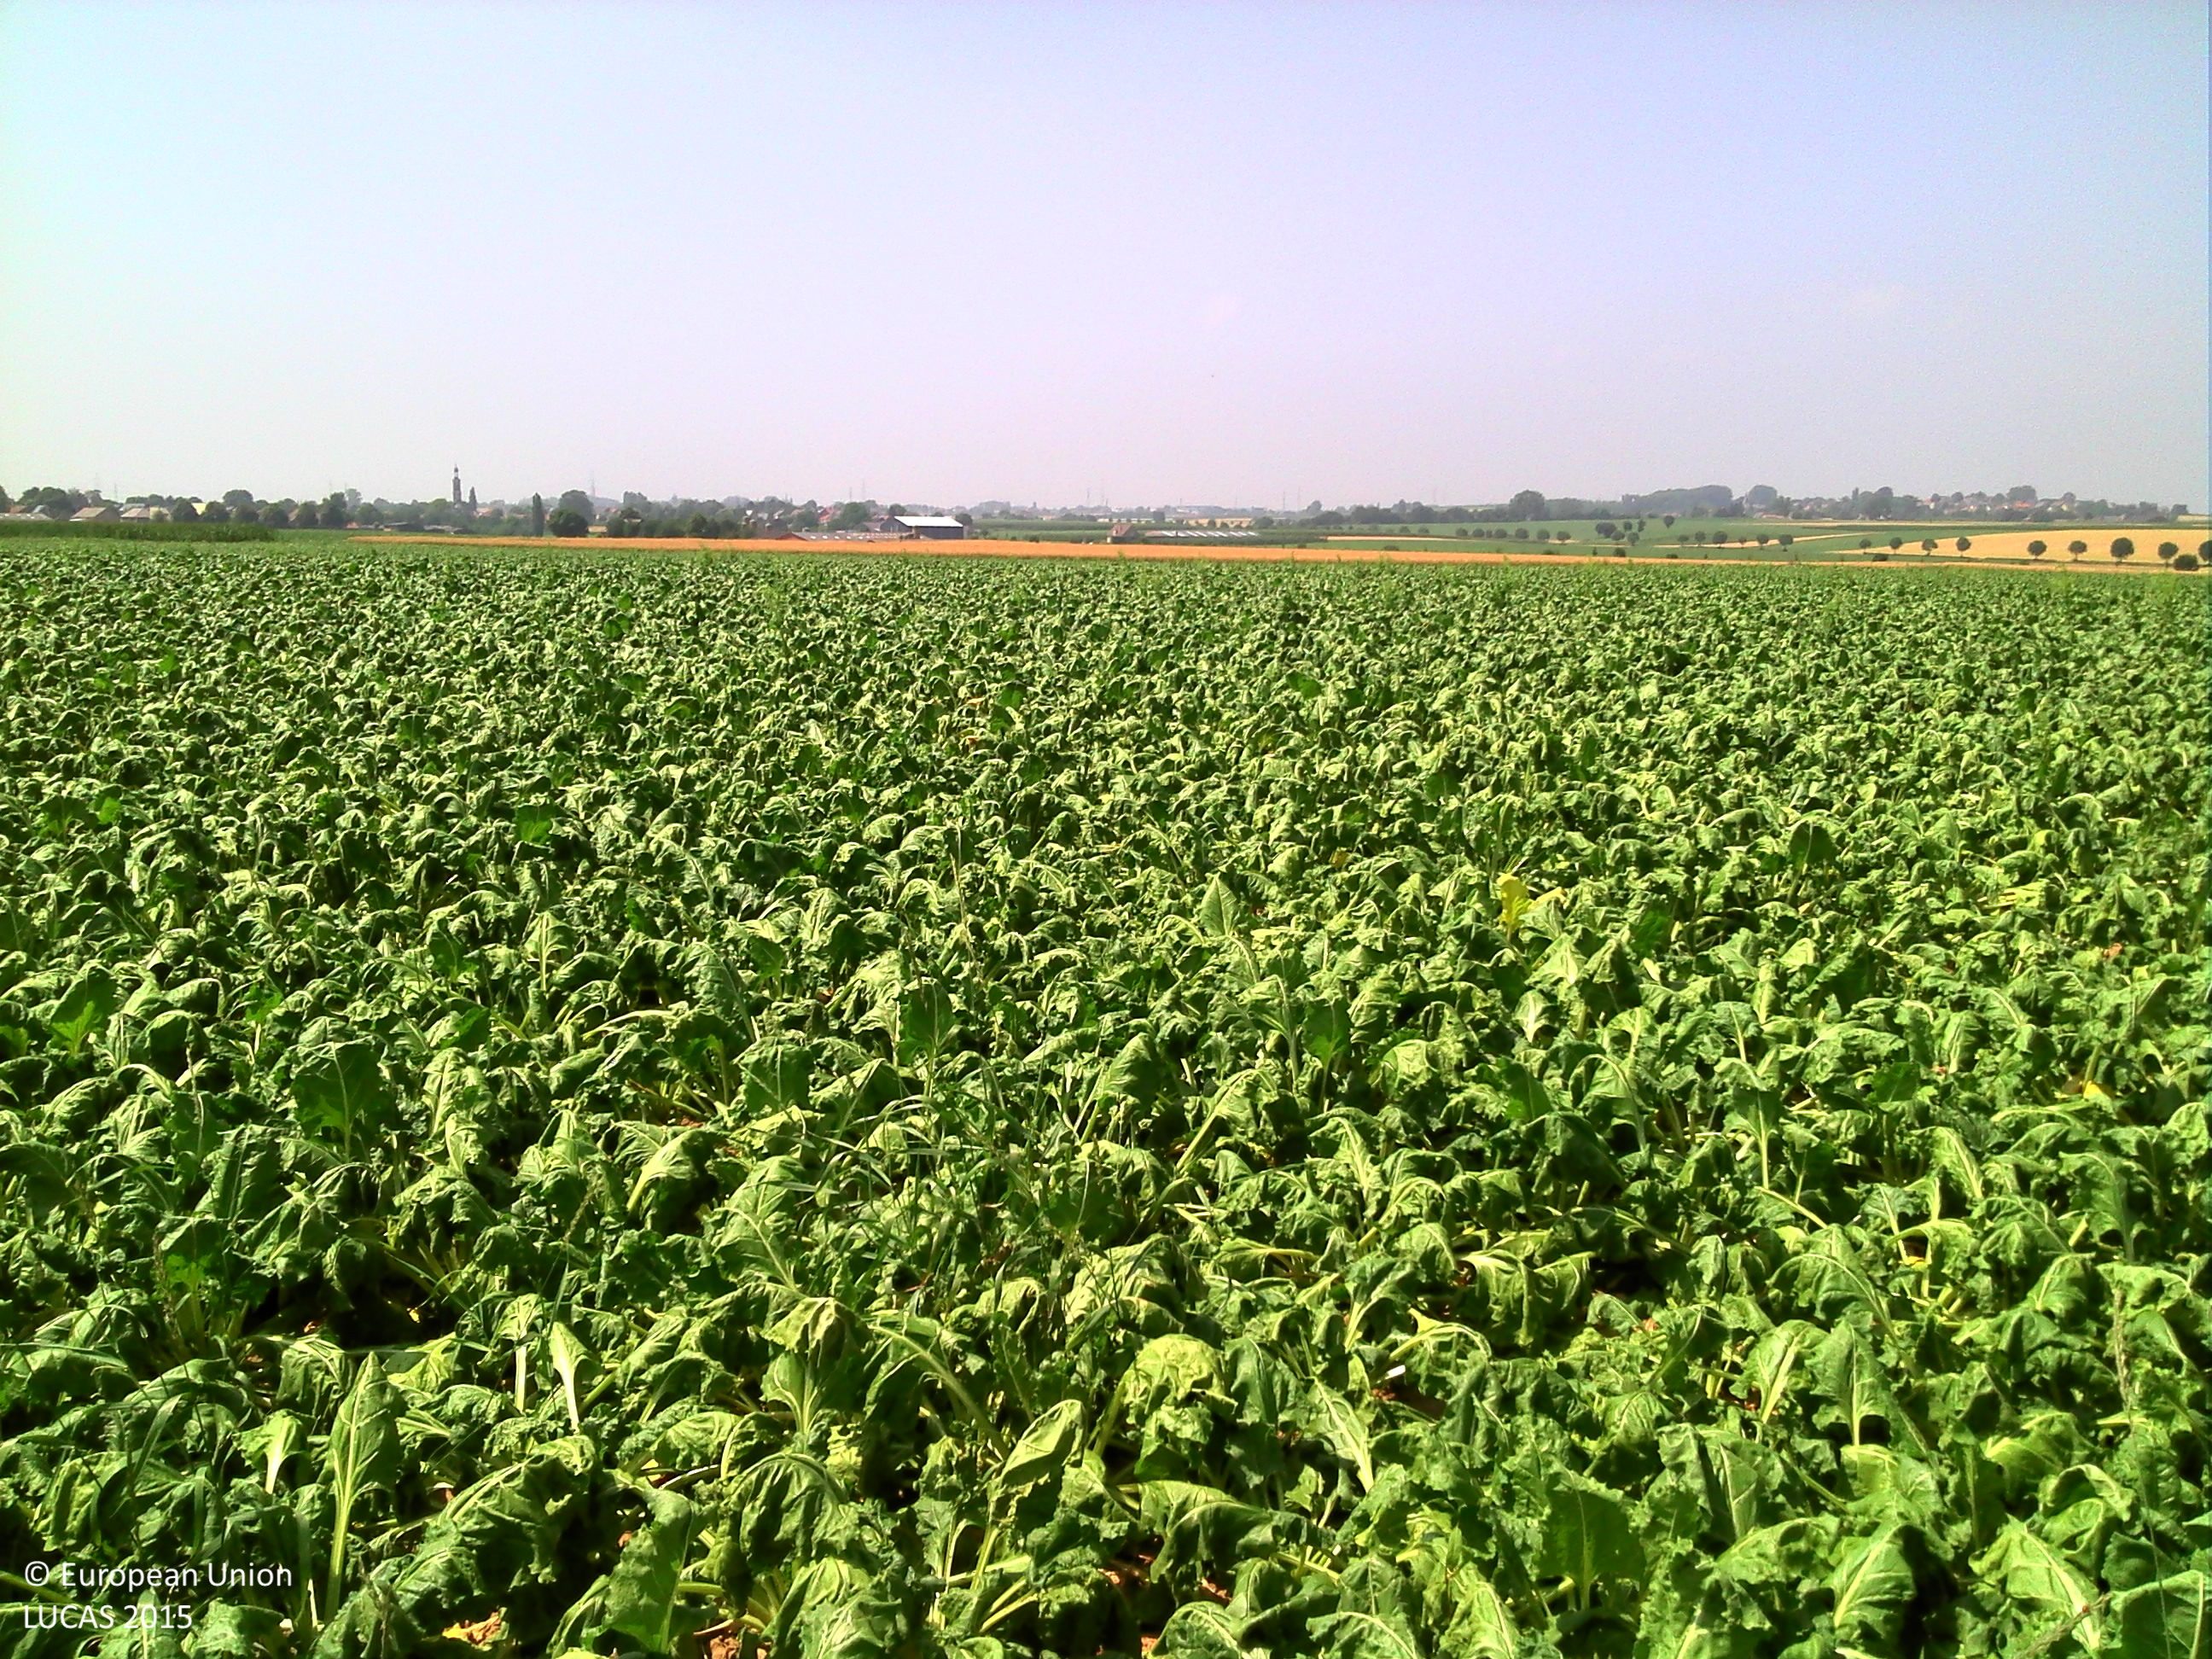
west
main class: Cropland
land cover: Sugar beet
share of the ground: > 75 %
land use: Agriculture (excluding fallow land and kitchen gardens)
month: July
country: BE
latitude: 50.8381
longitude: 5.6105
